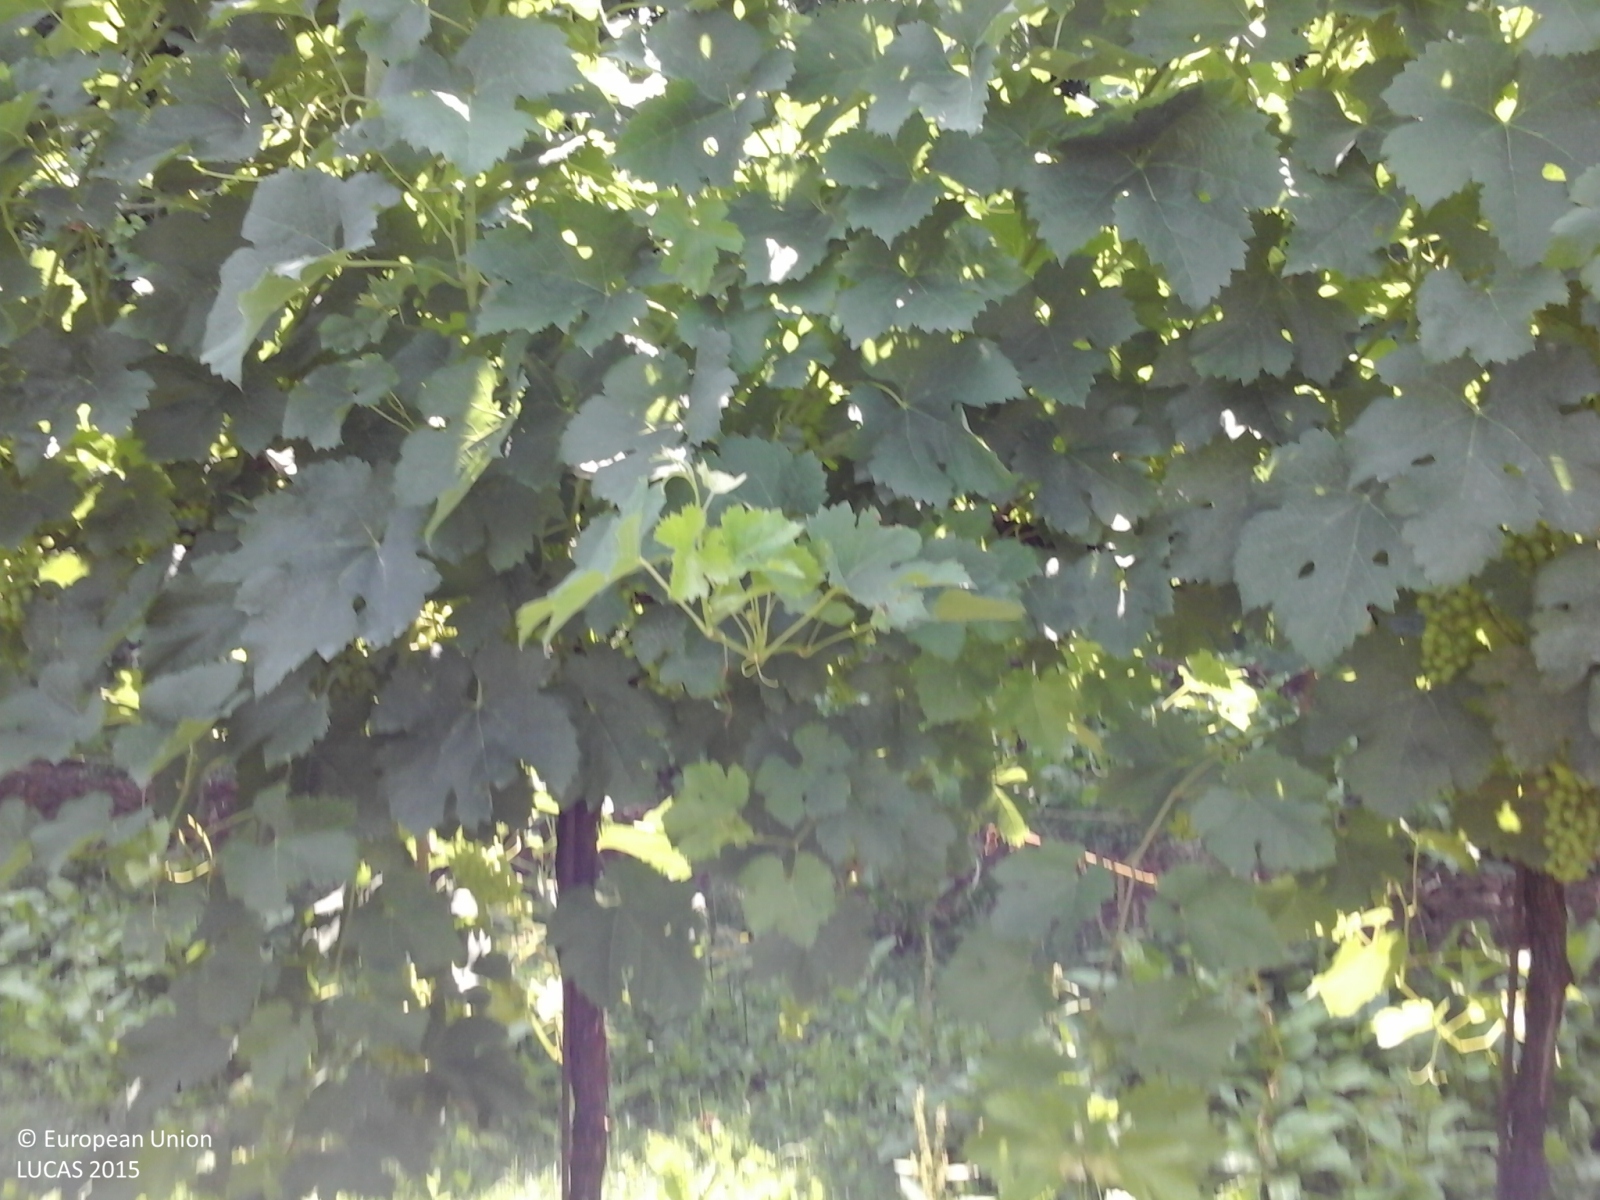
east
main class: Cropland
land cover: Vineyards
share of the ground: 25 - 50 %
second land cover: Grassland without tree/shrub cover
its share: > 75 %
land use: Agriculture (excluding fallow land and kitchen gardens)
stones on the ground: < 10 %
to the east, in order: Vineyards; Grassland without tree/shrub cover; Managed hedges; Ditches and canals; Managed hedges; Grassland without tree/shrub cover; Other fresh vegetables; Abandoned hedges; Fences; Other fruit trees and berries; Broadleaved woodland; Fences; Abandoned hedges; Ditches and canals; Tracks; Grassland without tree/shrub cover; Maize; Lines of trees; Ditches and canals; Paved roads, cycling and walking lanes; Electric lines; Ditches and canals; Abandoned hedges; Grass margins; Soya
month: June
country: IT
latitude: 45.8928
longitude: 12.3552
